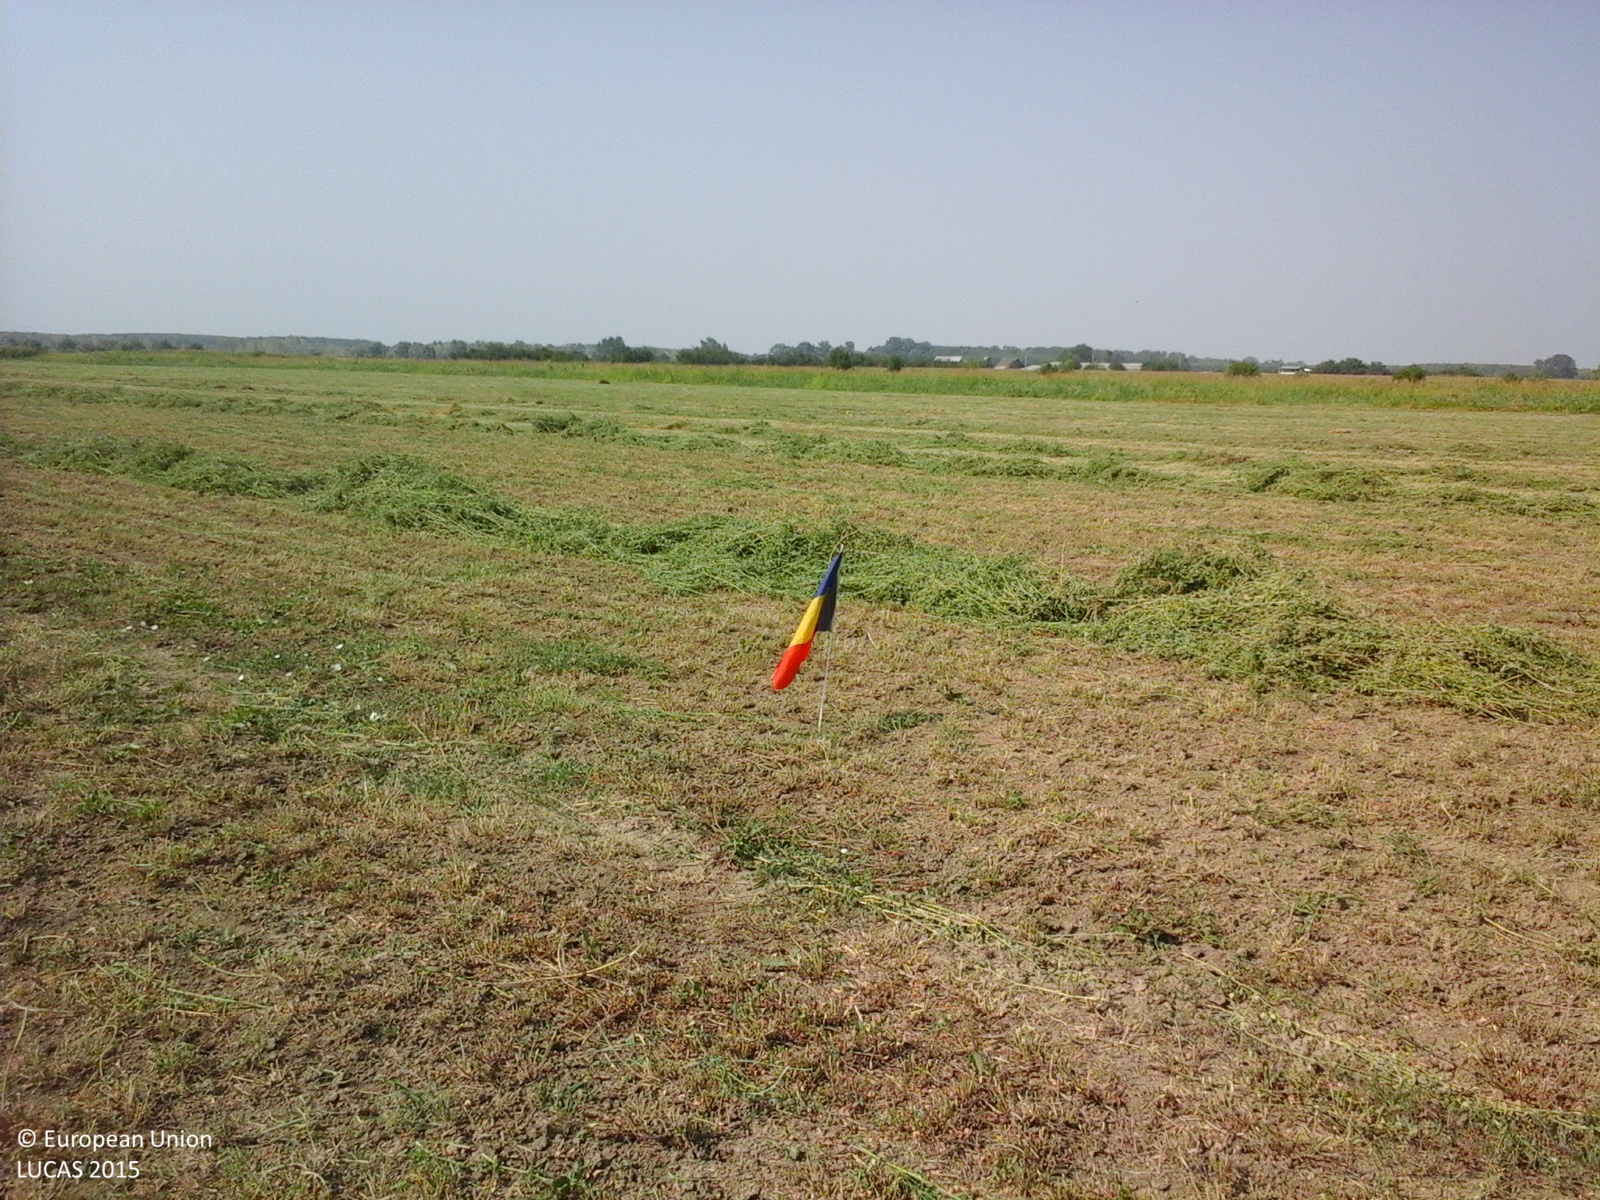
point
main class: Cropland
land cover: Lucerne
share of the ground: 10 - 25 %
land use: Agriculture (excluding fallow land and kitchen gardens)
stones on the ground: < 10 %
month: July
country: RO
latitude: 45.6505
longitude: 27.4906
